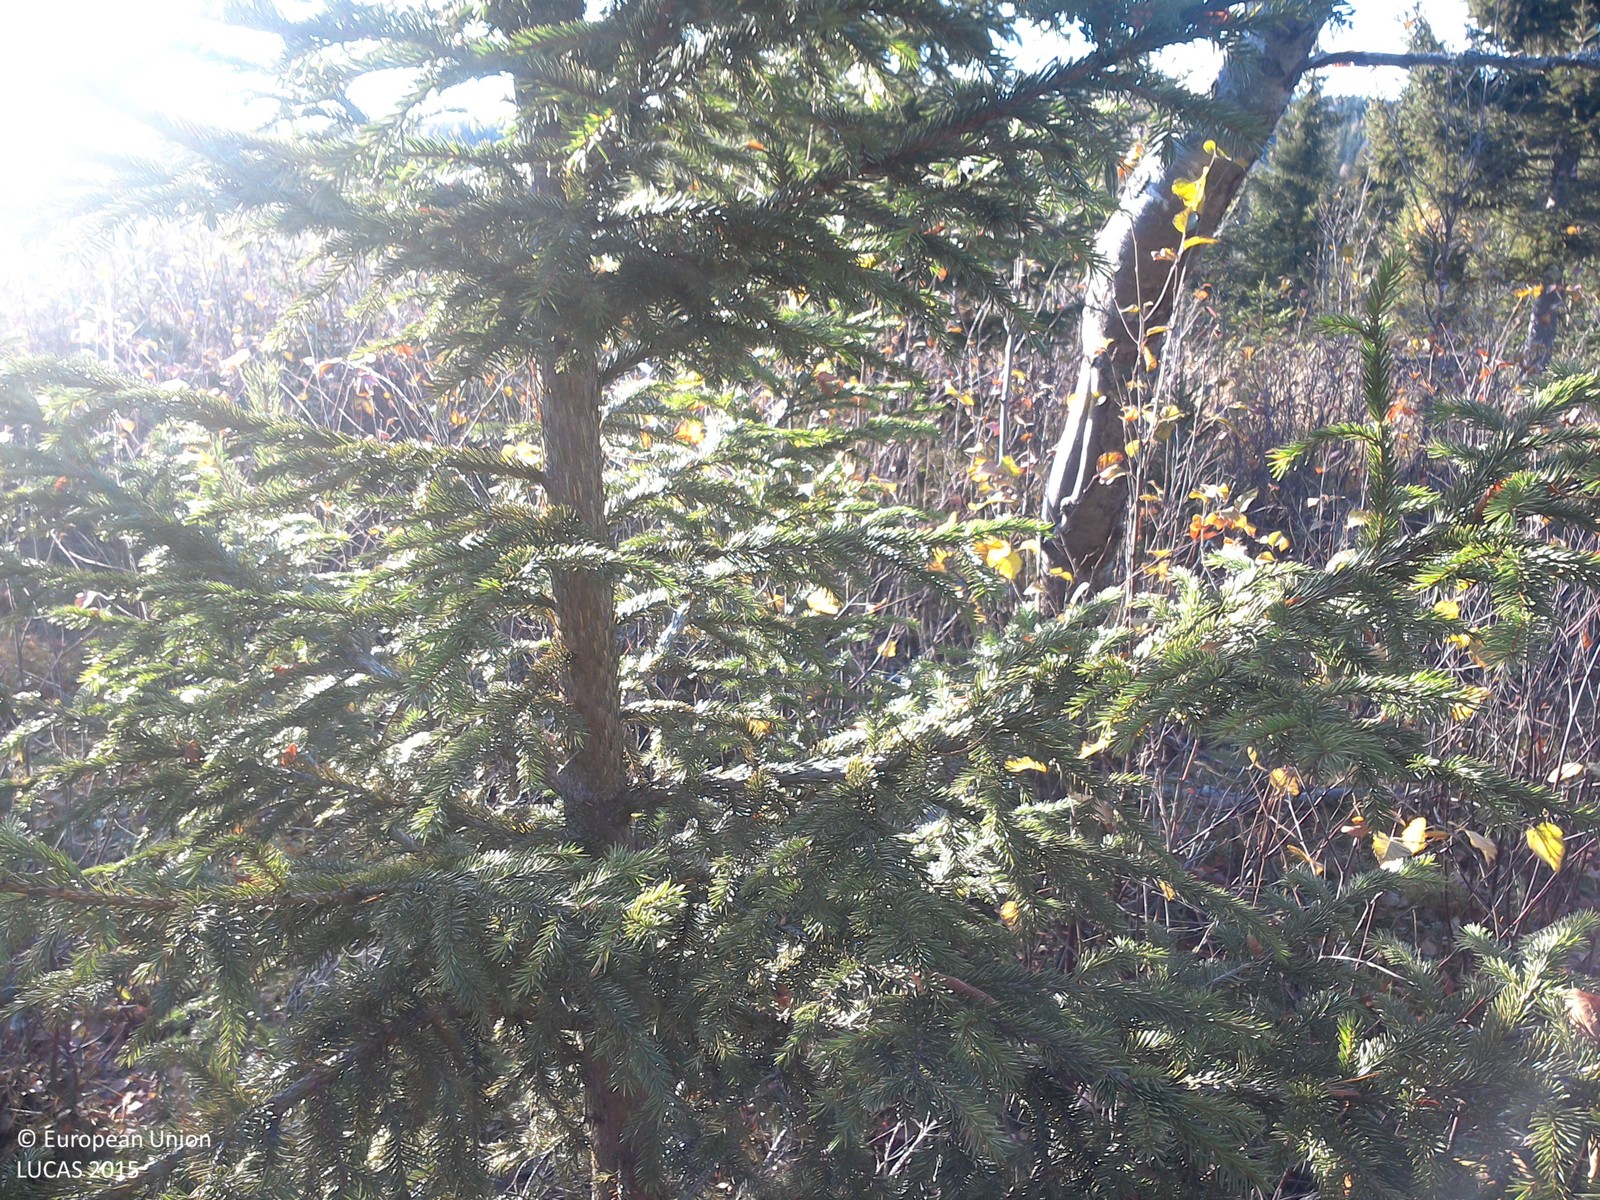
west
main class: Woodland
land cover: Spruce dominated mixed woodland
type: boreal forest
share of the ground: 25 - 50 %
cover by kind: shrubs 50 %, coniferous forest trees 30 %, broadleaved forest trees 20 %
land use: Forestry
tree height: > 5 m
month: October
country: SE
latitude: 63.8852
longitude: 19.6498
